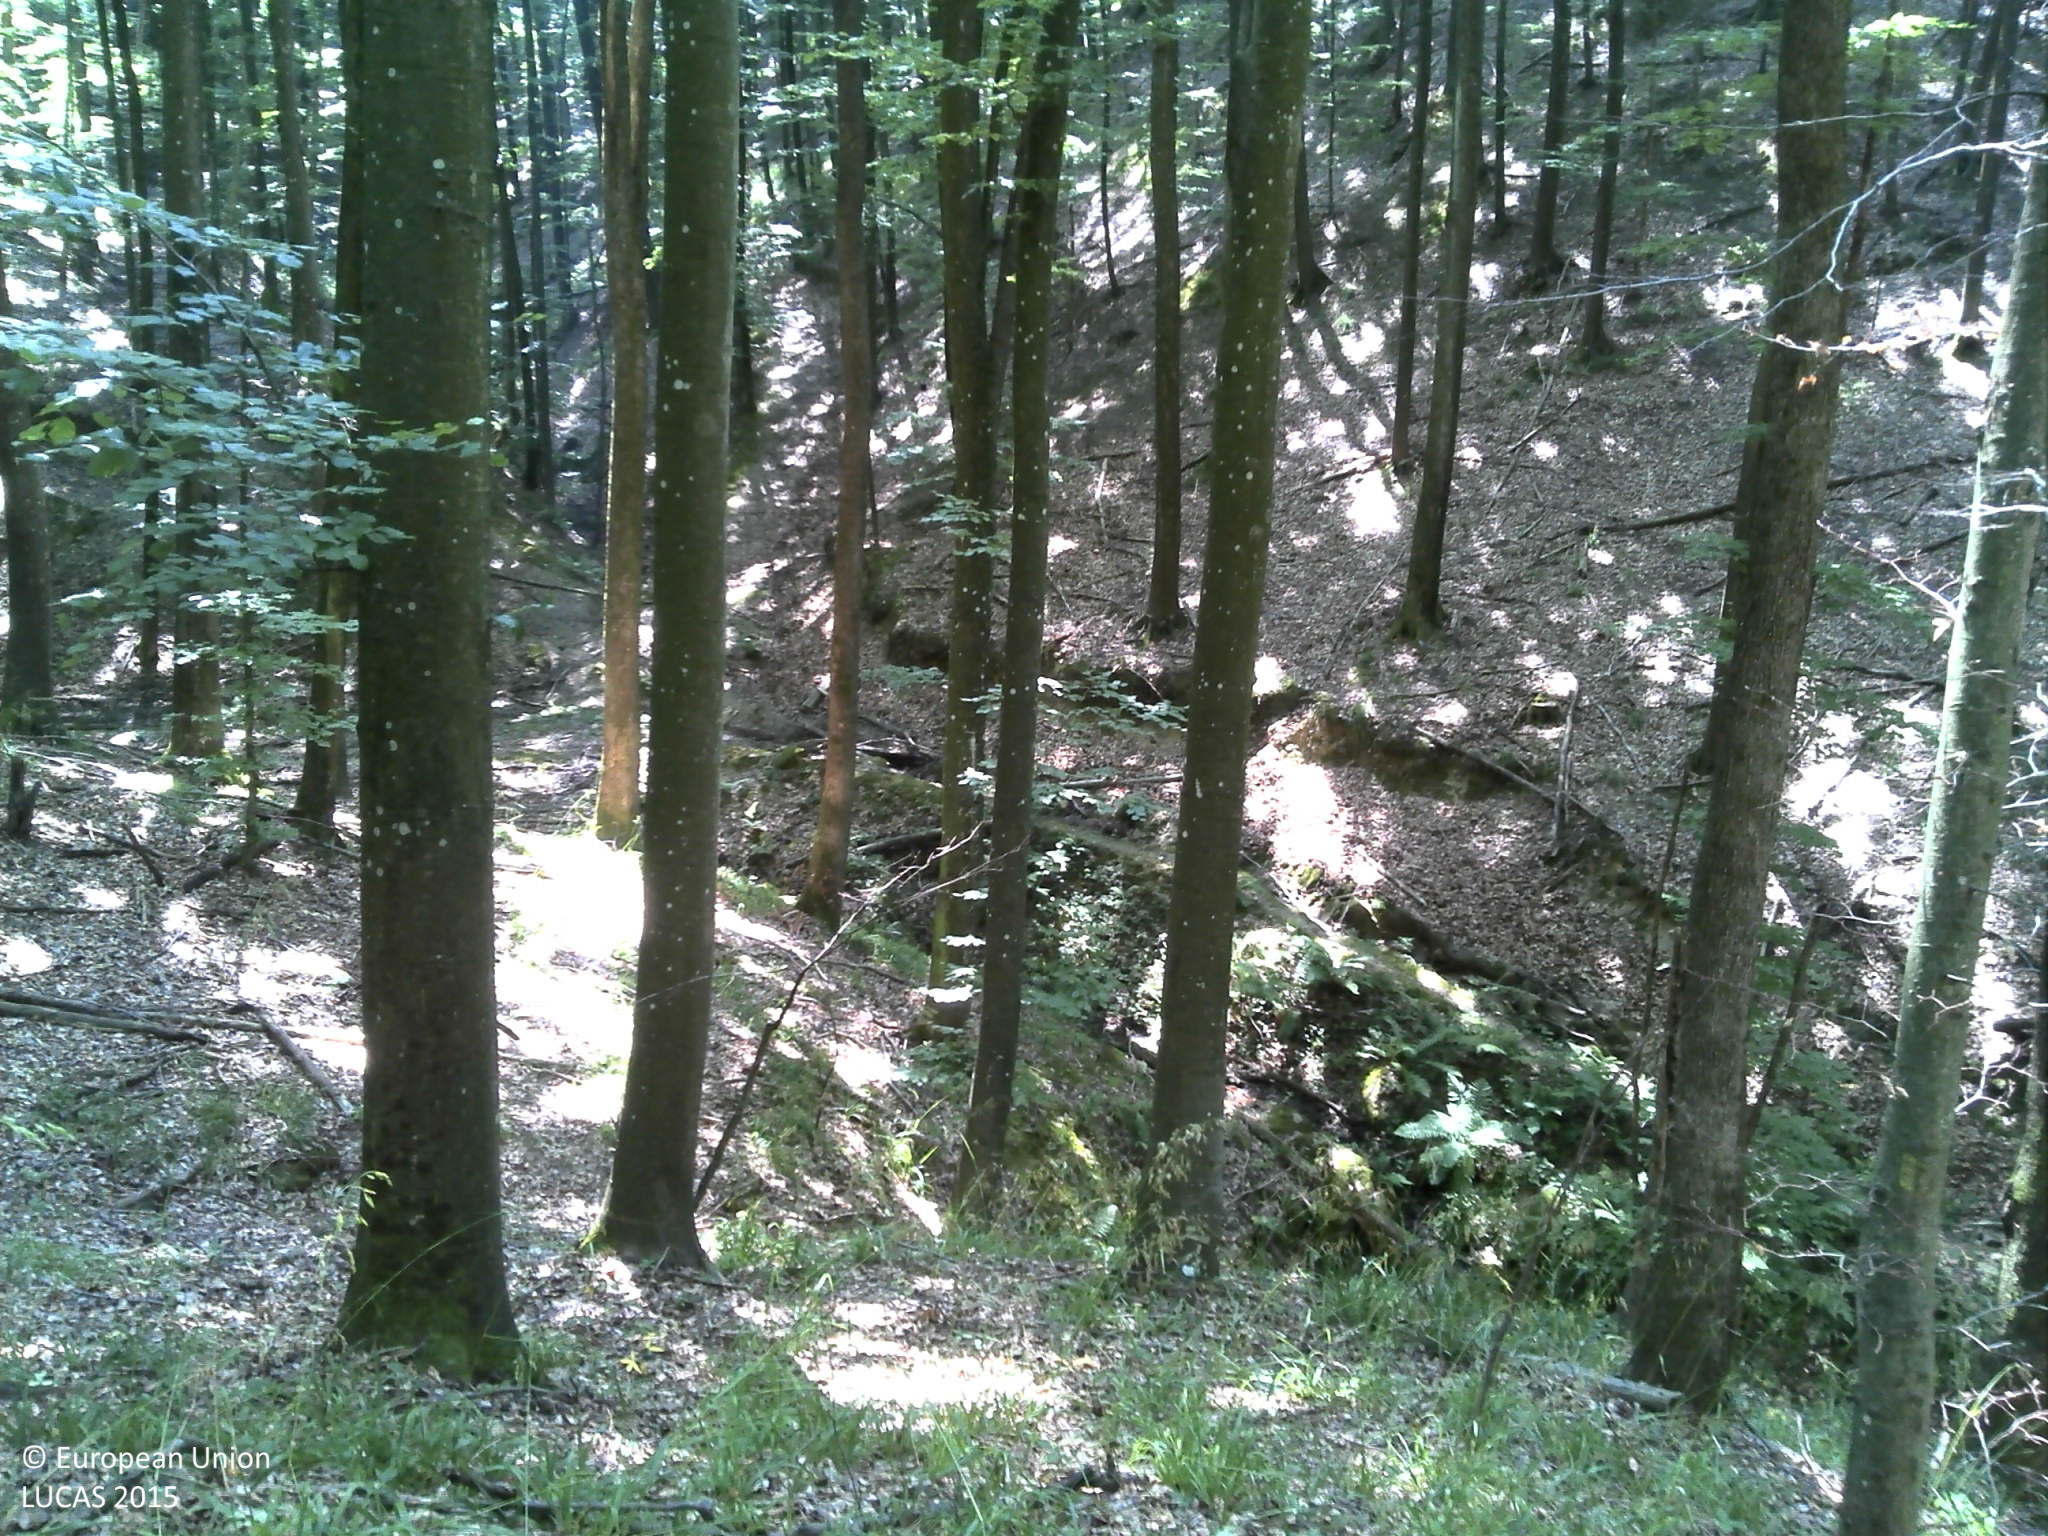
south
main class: Woodland
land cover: Broadleaved woodland
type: acidophilous oak and oak-birch forest
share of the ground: > 75 %
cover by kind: broadleaved forest trees 90 %, shrubs 5 %, herbaceous plants 5 %
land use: Forestry
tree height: > 5 m
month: July
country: HR
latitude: 45.6752
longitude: 16.6361
